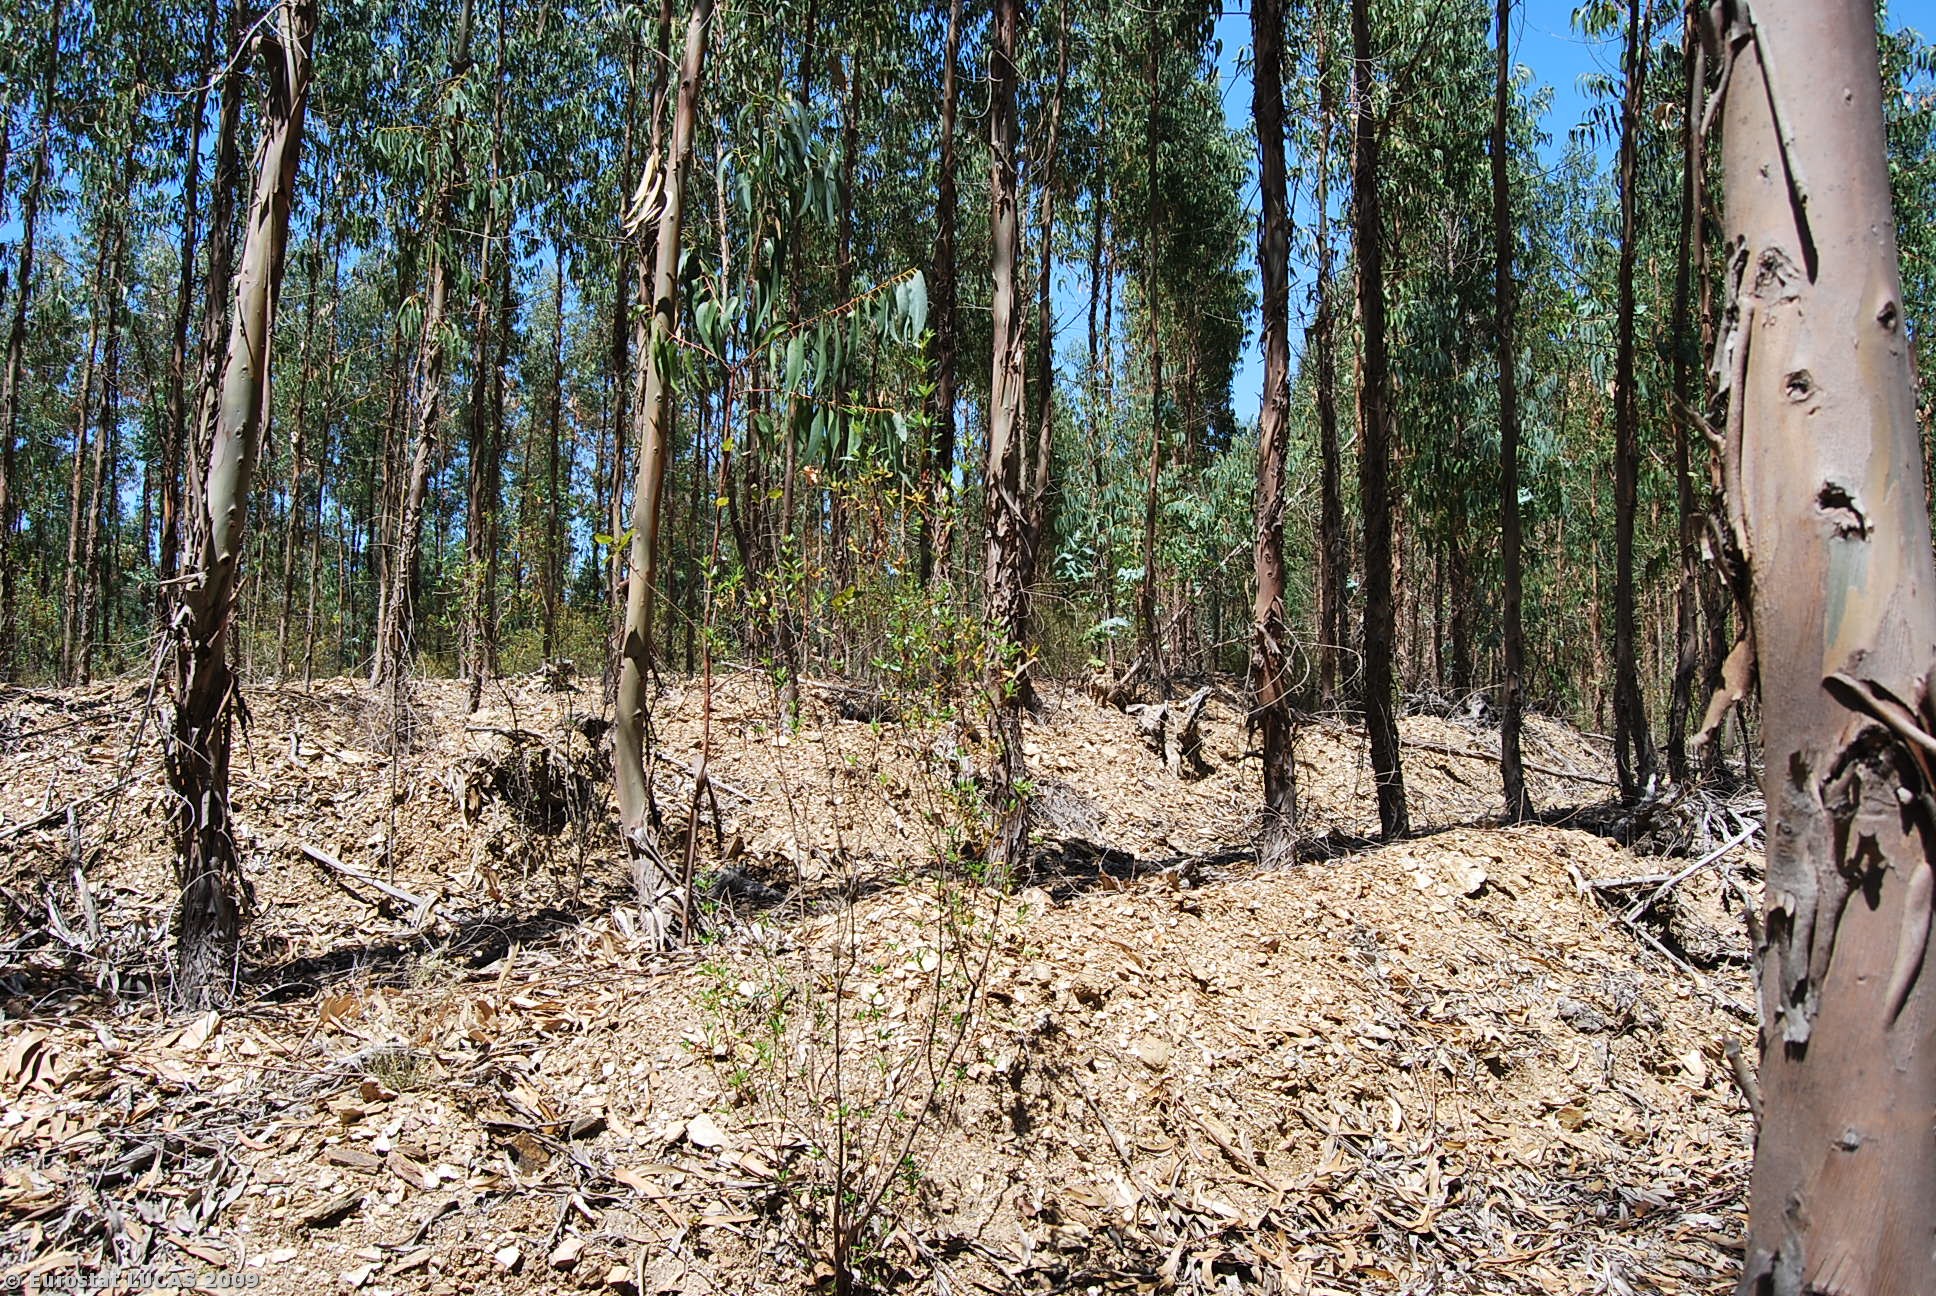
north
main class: Woodland
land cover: Broadleaved woodland
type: plantations and self-sown exotic forest
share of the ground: 50 - 75 %
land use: Forestry
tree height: > 5 m
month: July
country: PT
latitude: 37.6790
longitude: -8.4839
